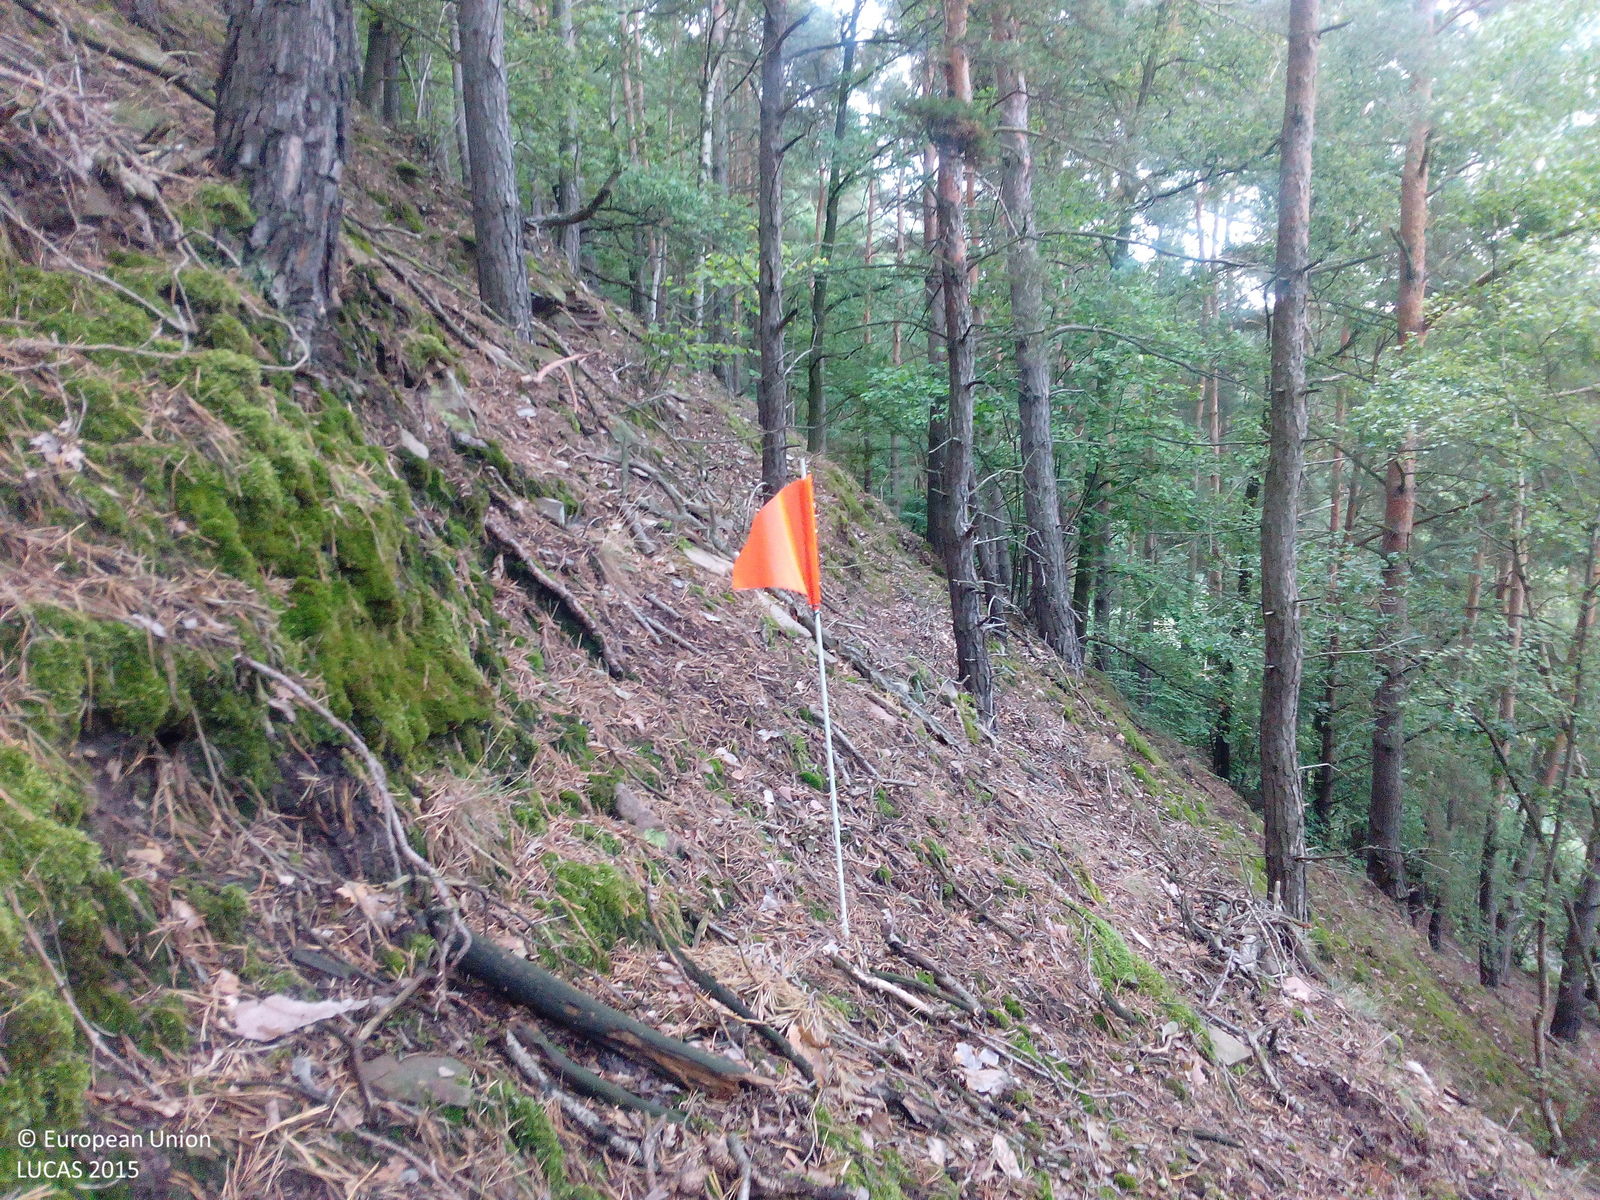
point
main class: Woodland
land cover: Pine dominated coniferous woodland
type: hemiboreal forest and nemoral coniferous forest and mixed broadleaved-coniferous forest
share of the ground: > 75 %
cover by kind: coniferous forest trees 95 %, broadleaved forest trees 5 %
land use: Forestry
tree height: > 5 m
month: August
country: DE
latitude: 50.8132
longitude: 10.2696
